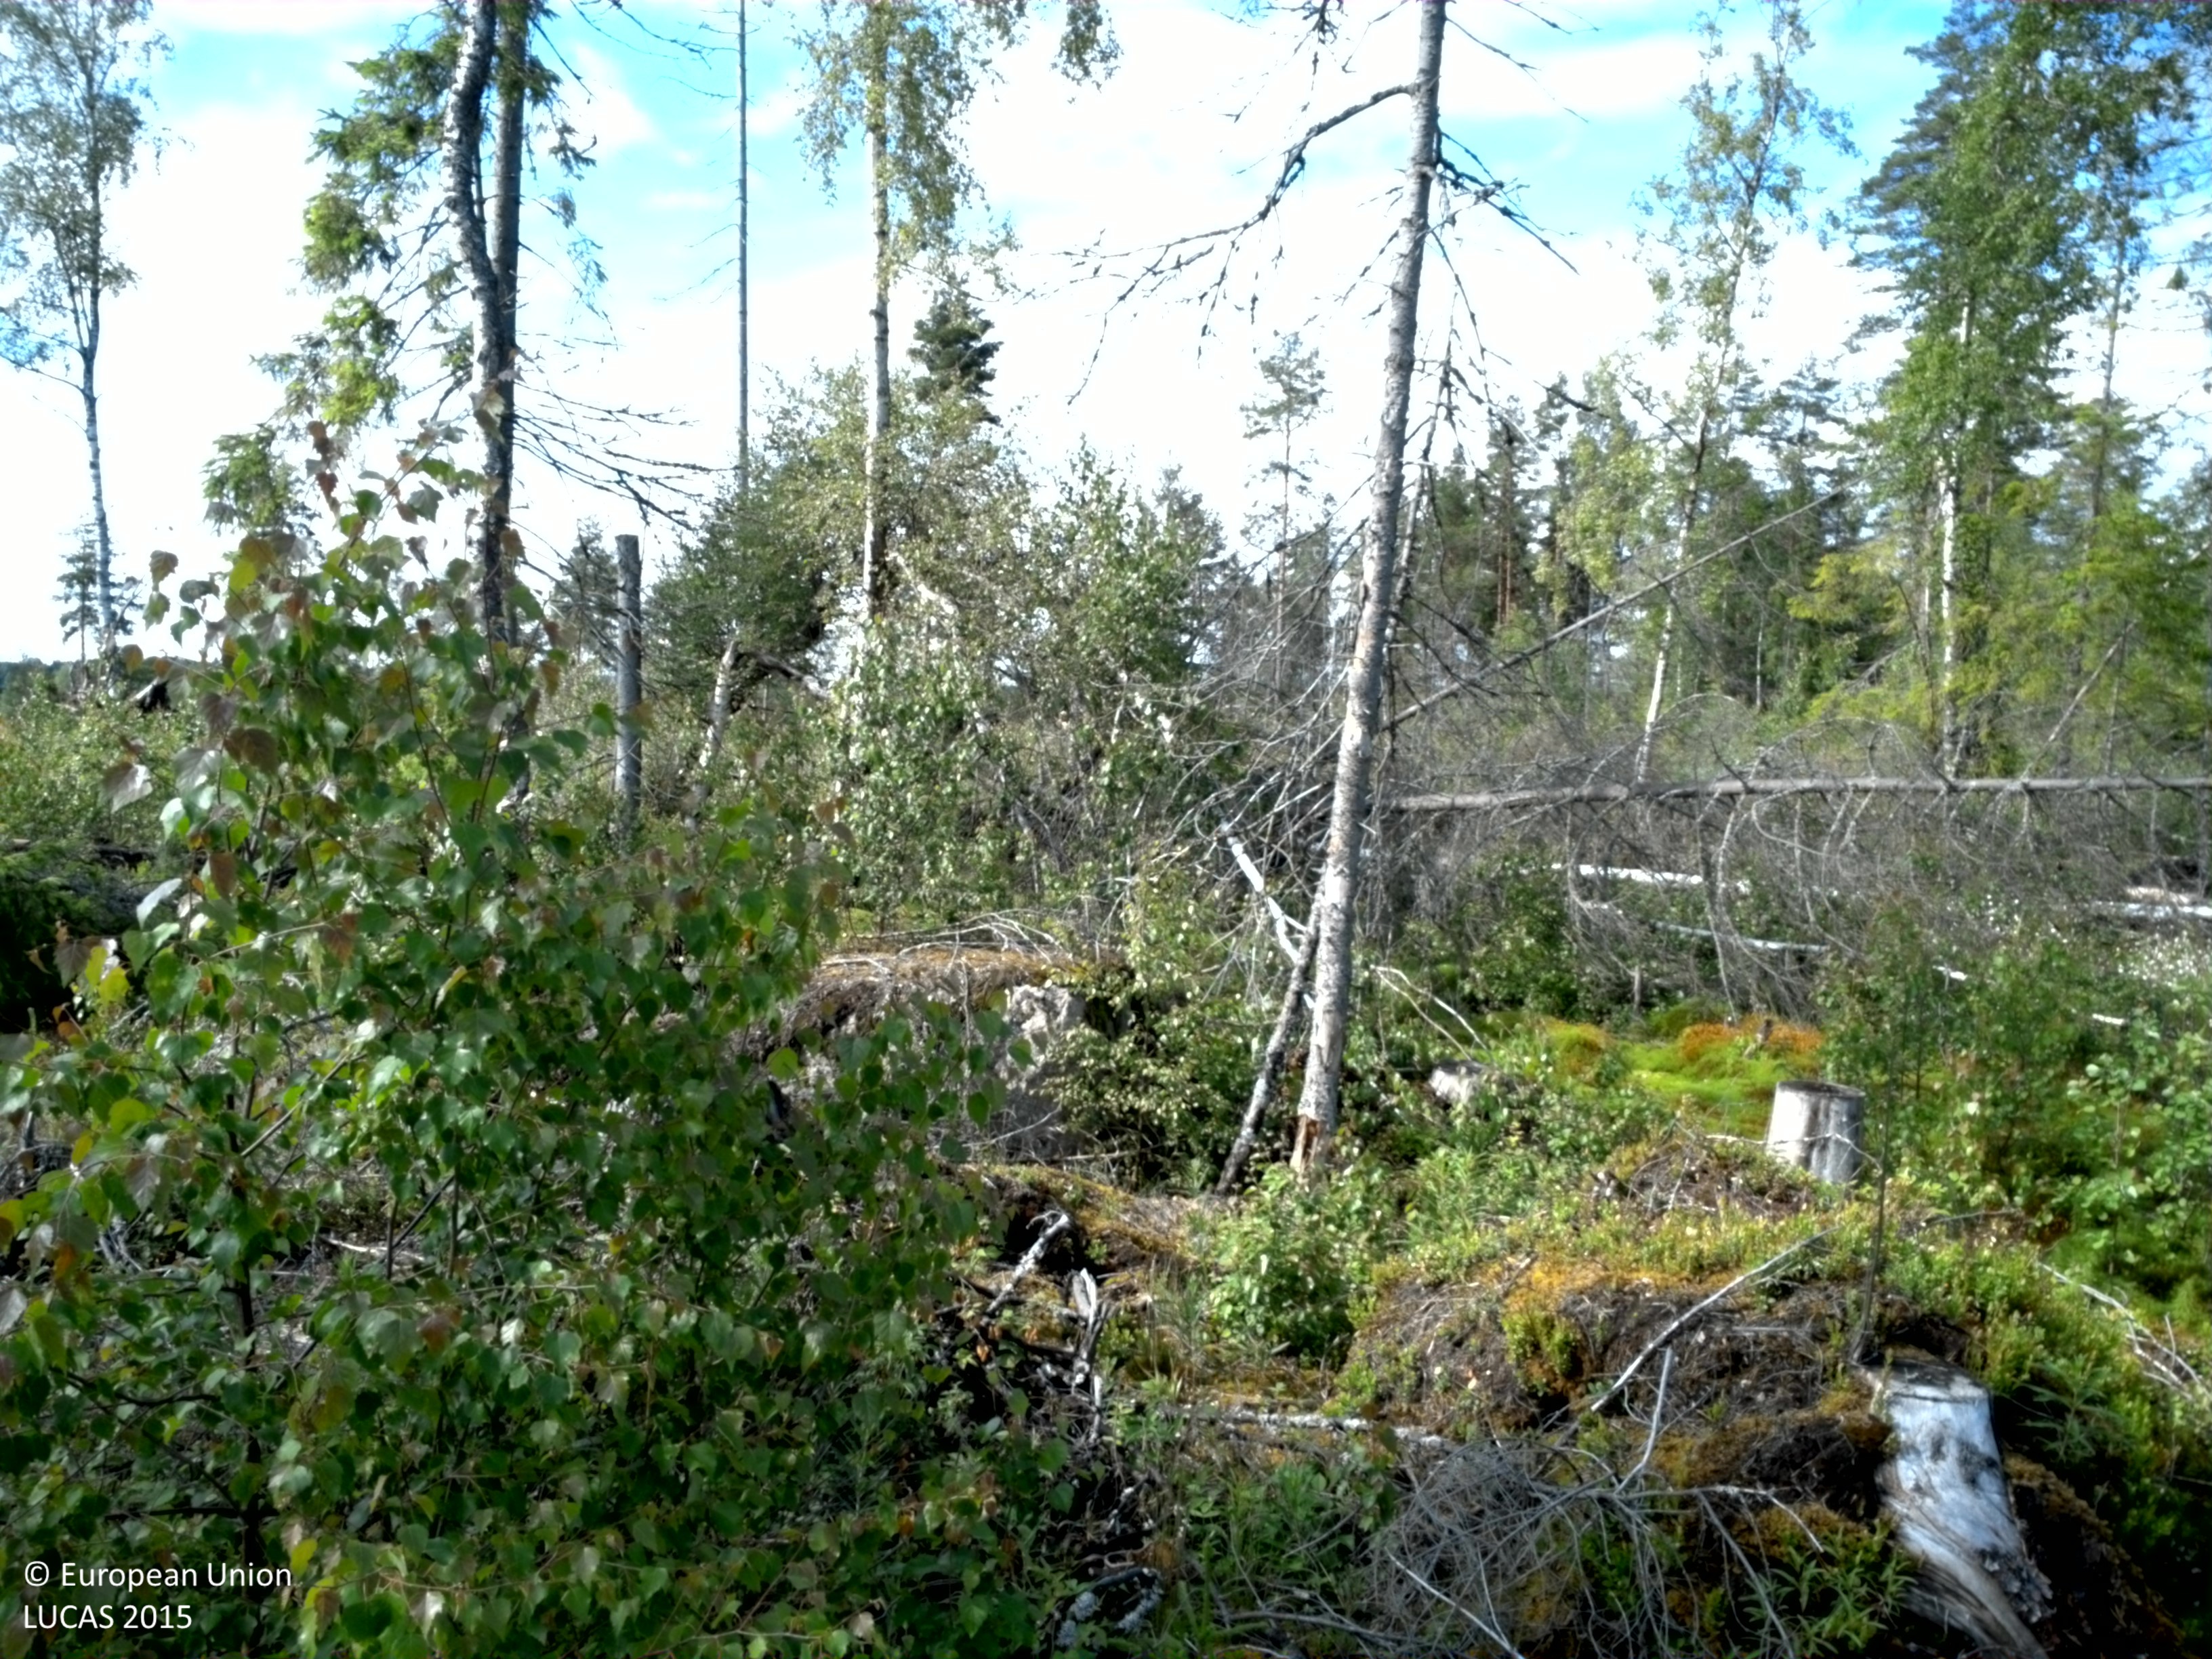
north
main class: Woodland
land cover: Broadleaved woodland
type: boreal forest
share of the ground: 10 - 25 %
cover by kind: lichens and mosses 55 %, broadleaved forest trees 20 %, herbaceous plants 20 %, coniferous forest trees 5 %
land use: Forestry
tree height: < 5 m
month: June
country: SE
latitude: 59.8957
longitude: 17.0525
